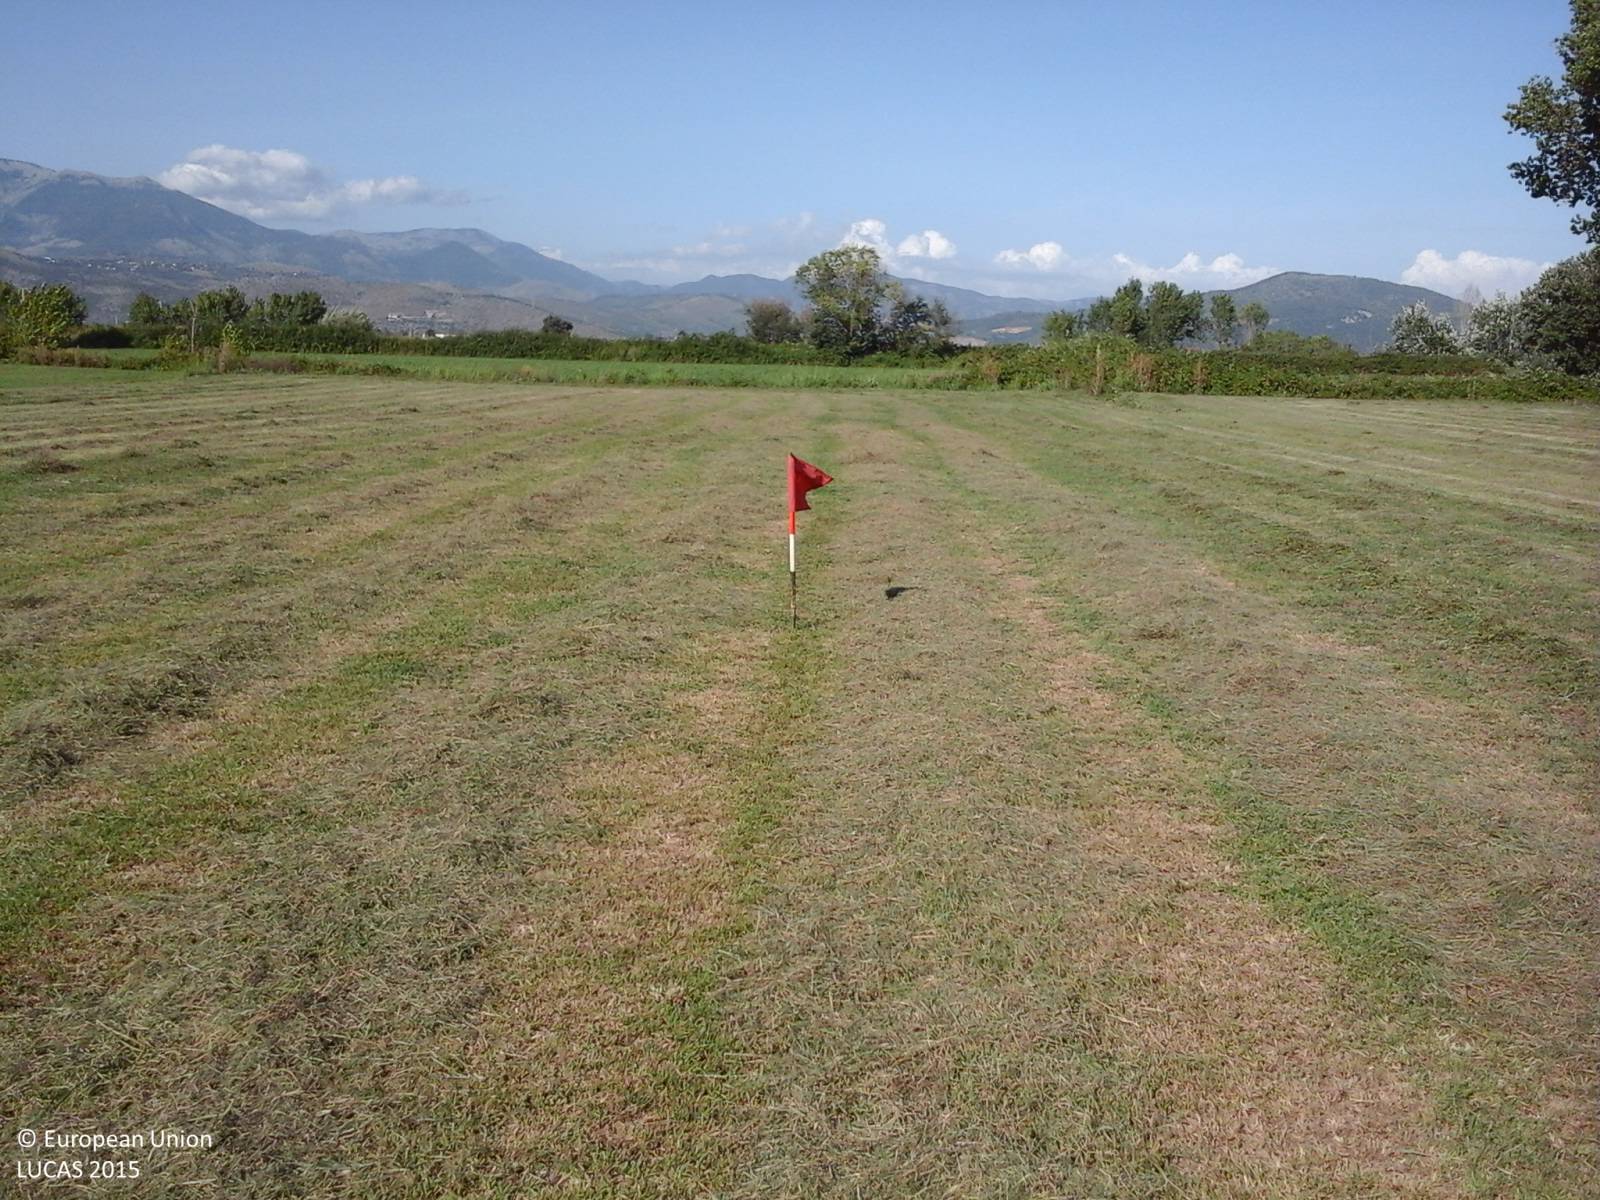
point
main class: Cropland
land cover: Temporary grasslands
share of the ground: > 75 %
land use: Agriculture (excluding fallow land and kitchen gardens)
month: August
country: IT
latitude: 41.4324
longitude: 13.0633
